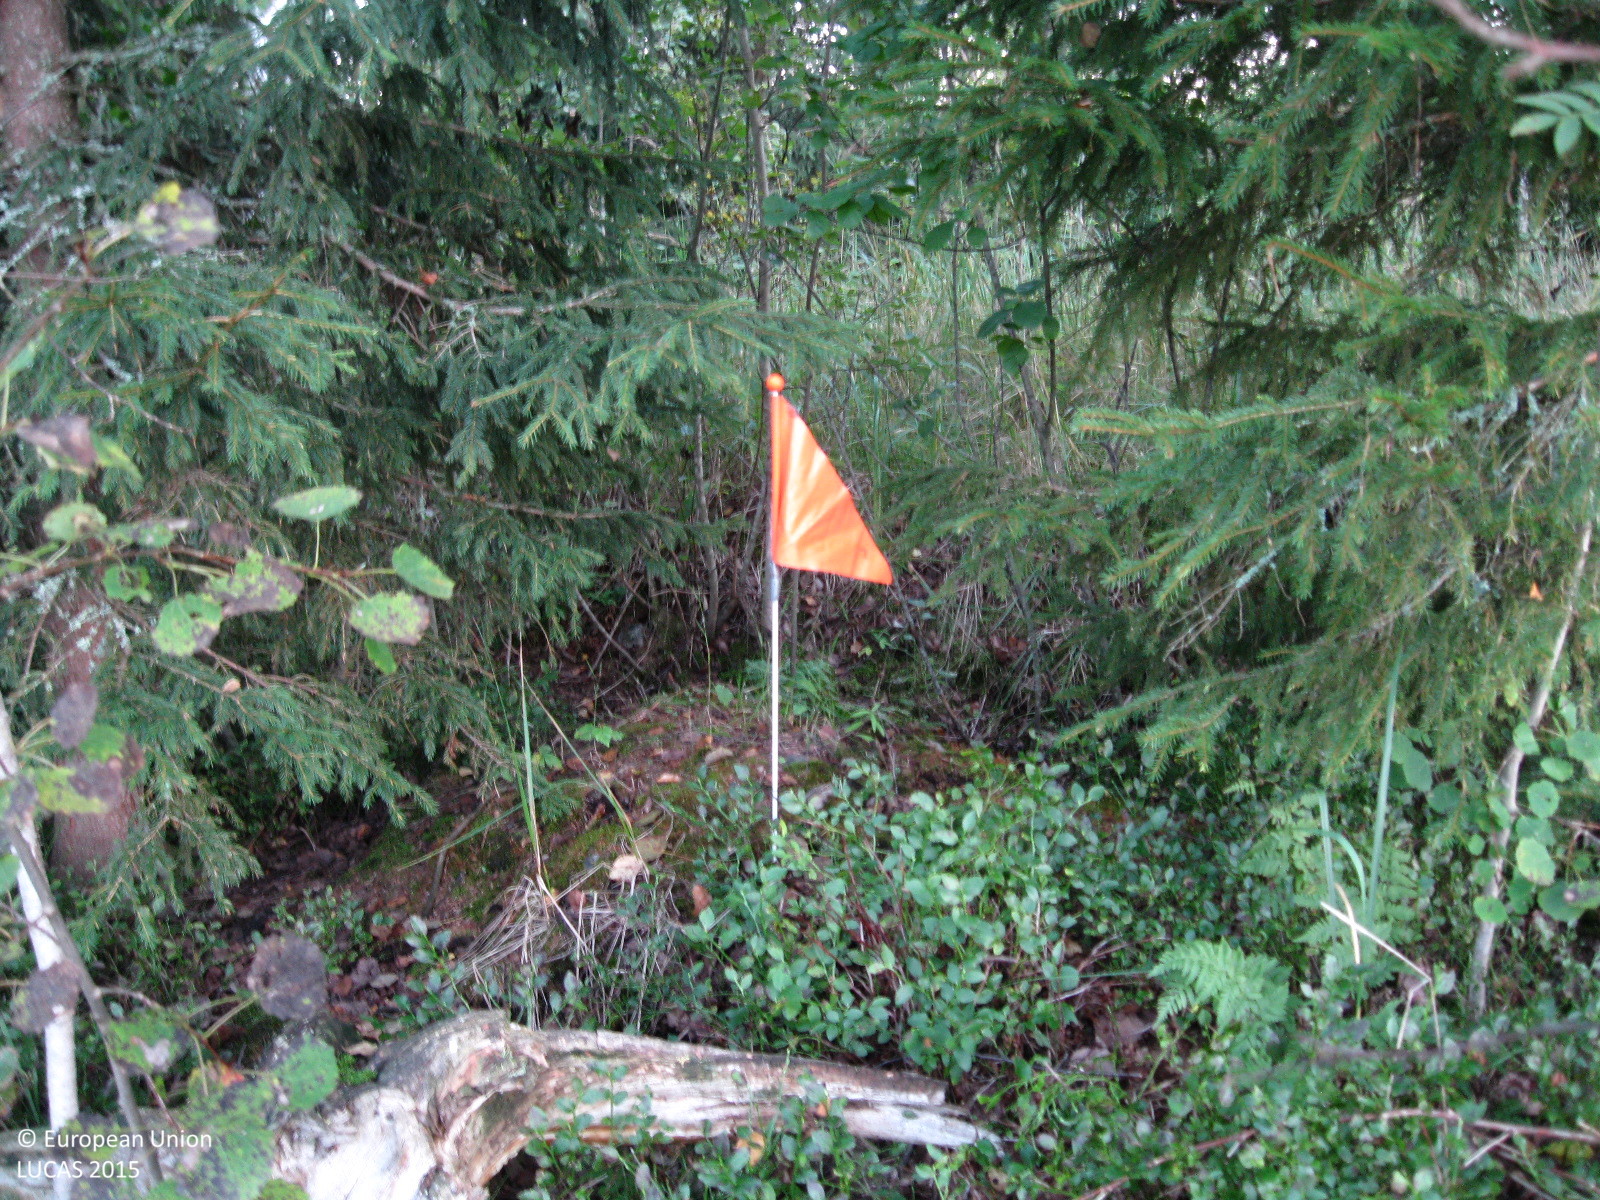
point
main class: Woodland
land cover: Spruce dominated mixed woodland
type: boreal forest
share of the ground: 50 - 75 %
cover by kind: coniferous forest trees 35 %, broadleaved forest trees 35 %, shrubs 25 %, herbaceous plants 5 %
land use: Forestry
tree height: < 5 m
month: September
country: FI
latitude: 60.6119
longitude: 24.7438
